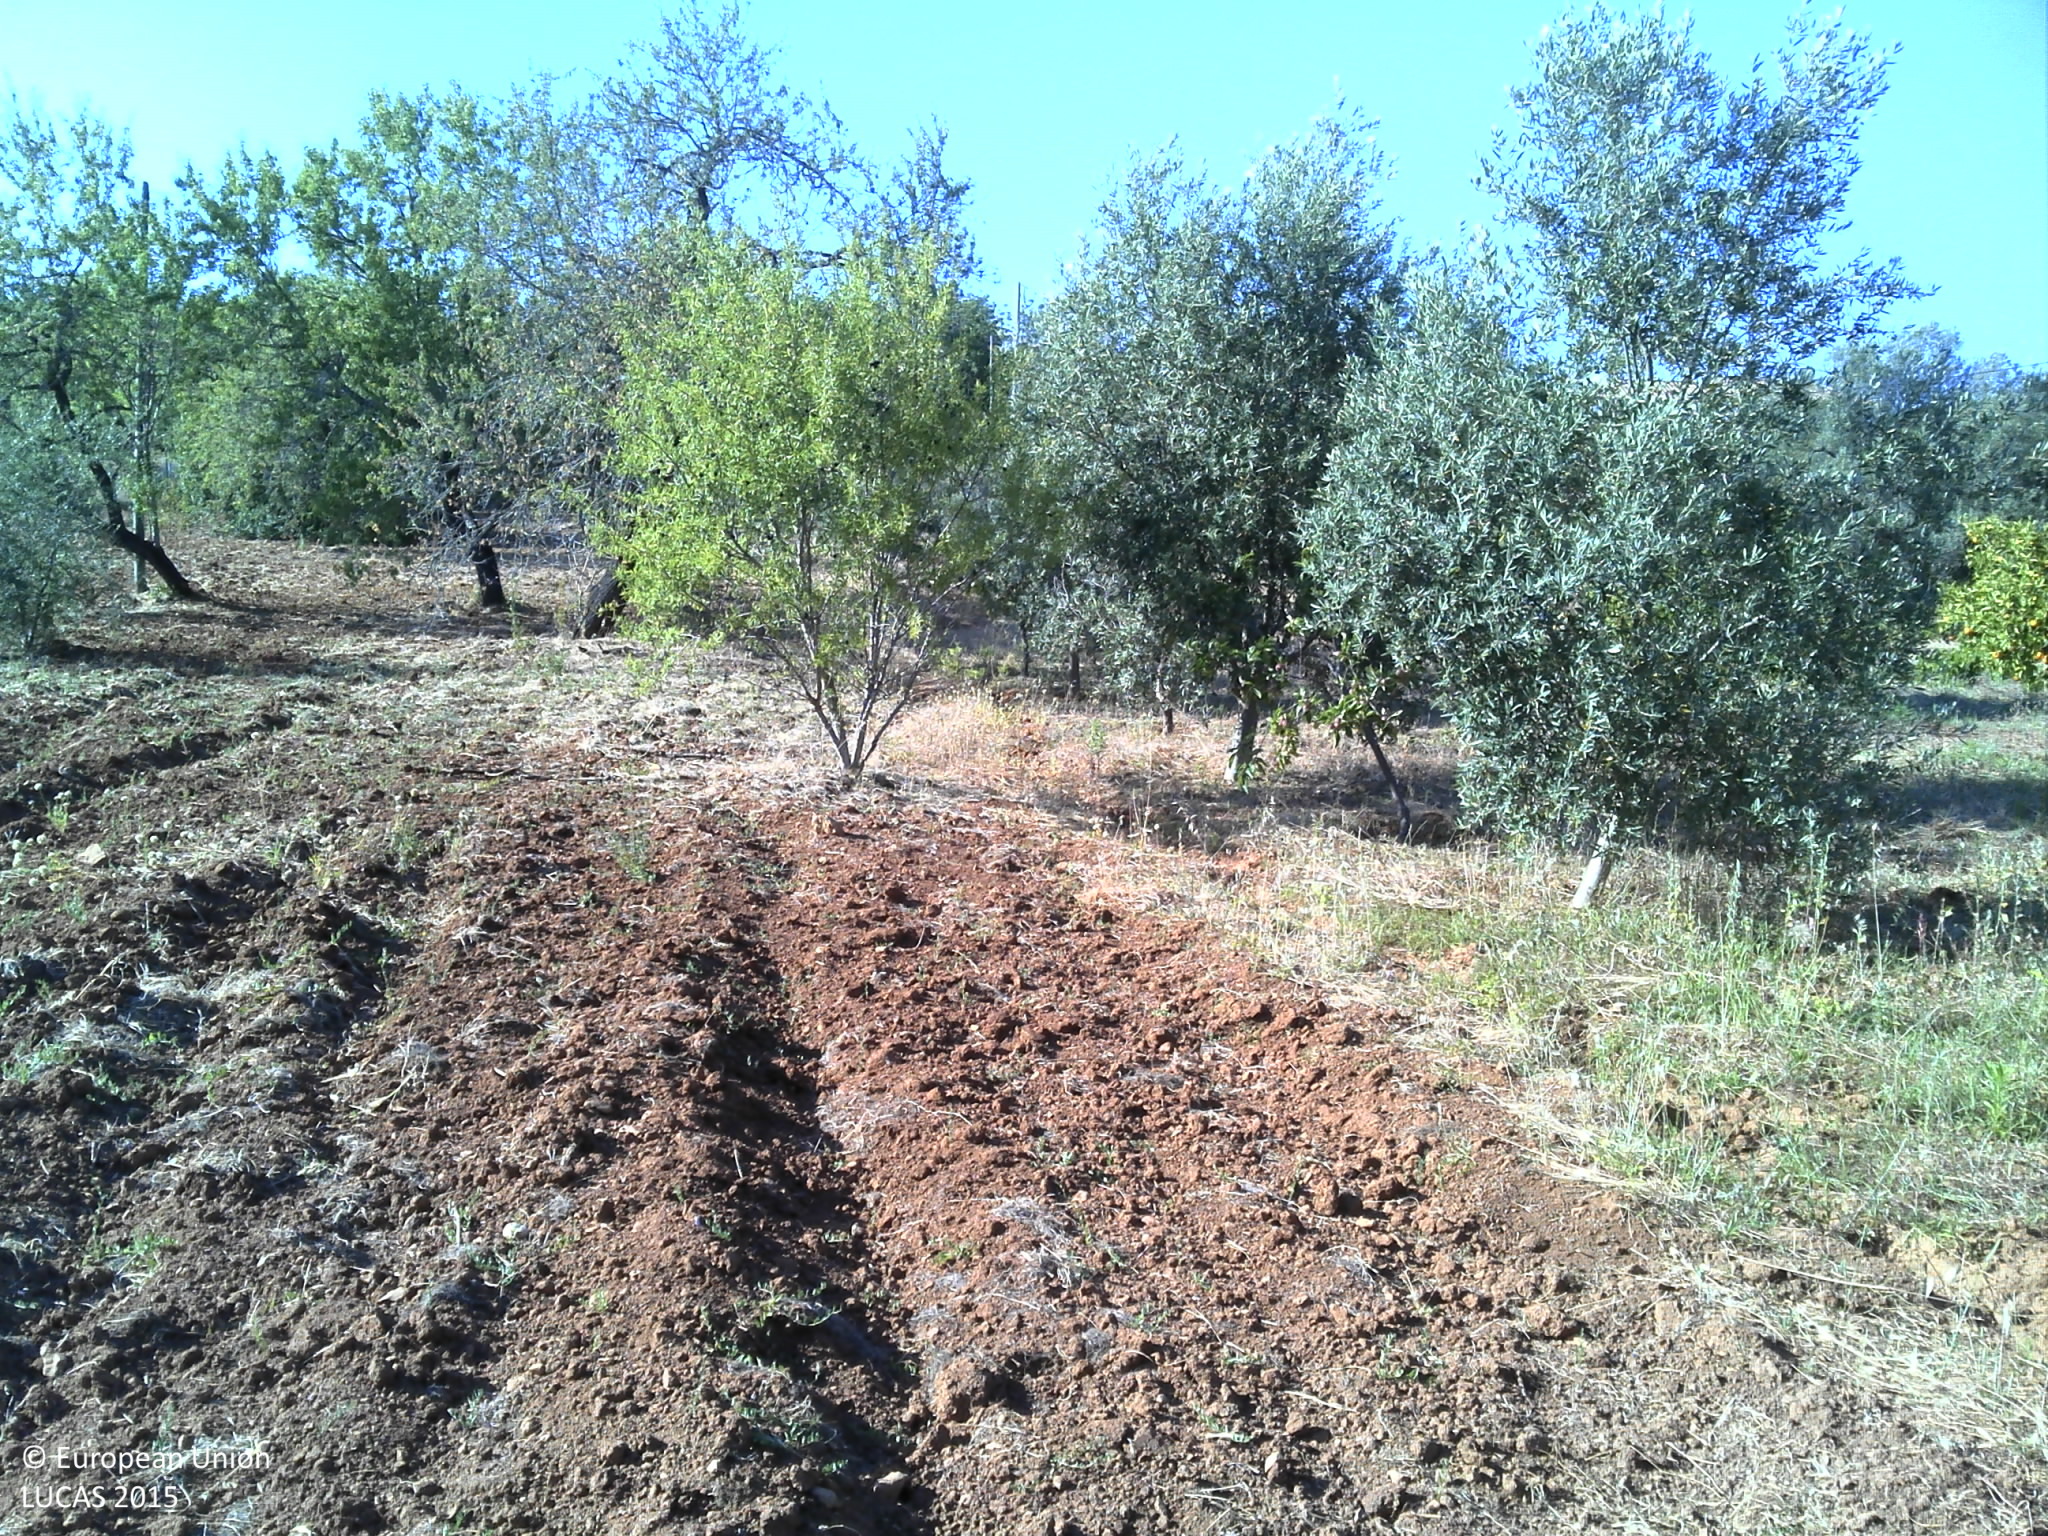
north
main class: Cropland
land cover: Permanent industrial crops
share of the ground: < 10 %
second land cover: Other bare soil
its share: > 75 %
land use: Agriculture (excluding fallow land and kitchen gardens)
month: June
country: PT
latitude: 37.0996
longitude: -7.7503
